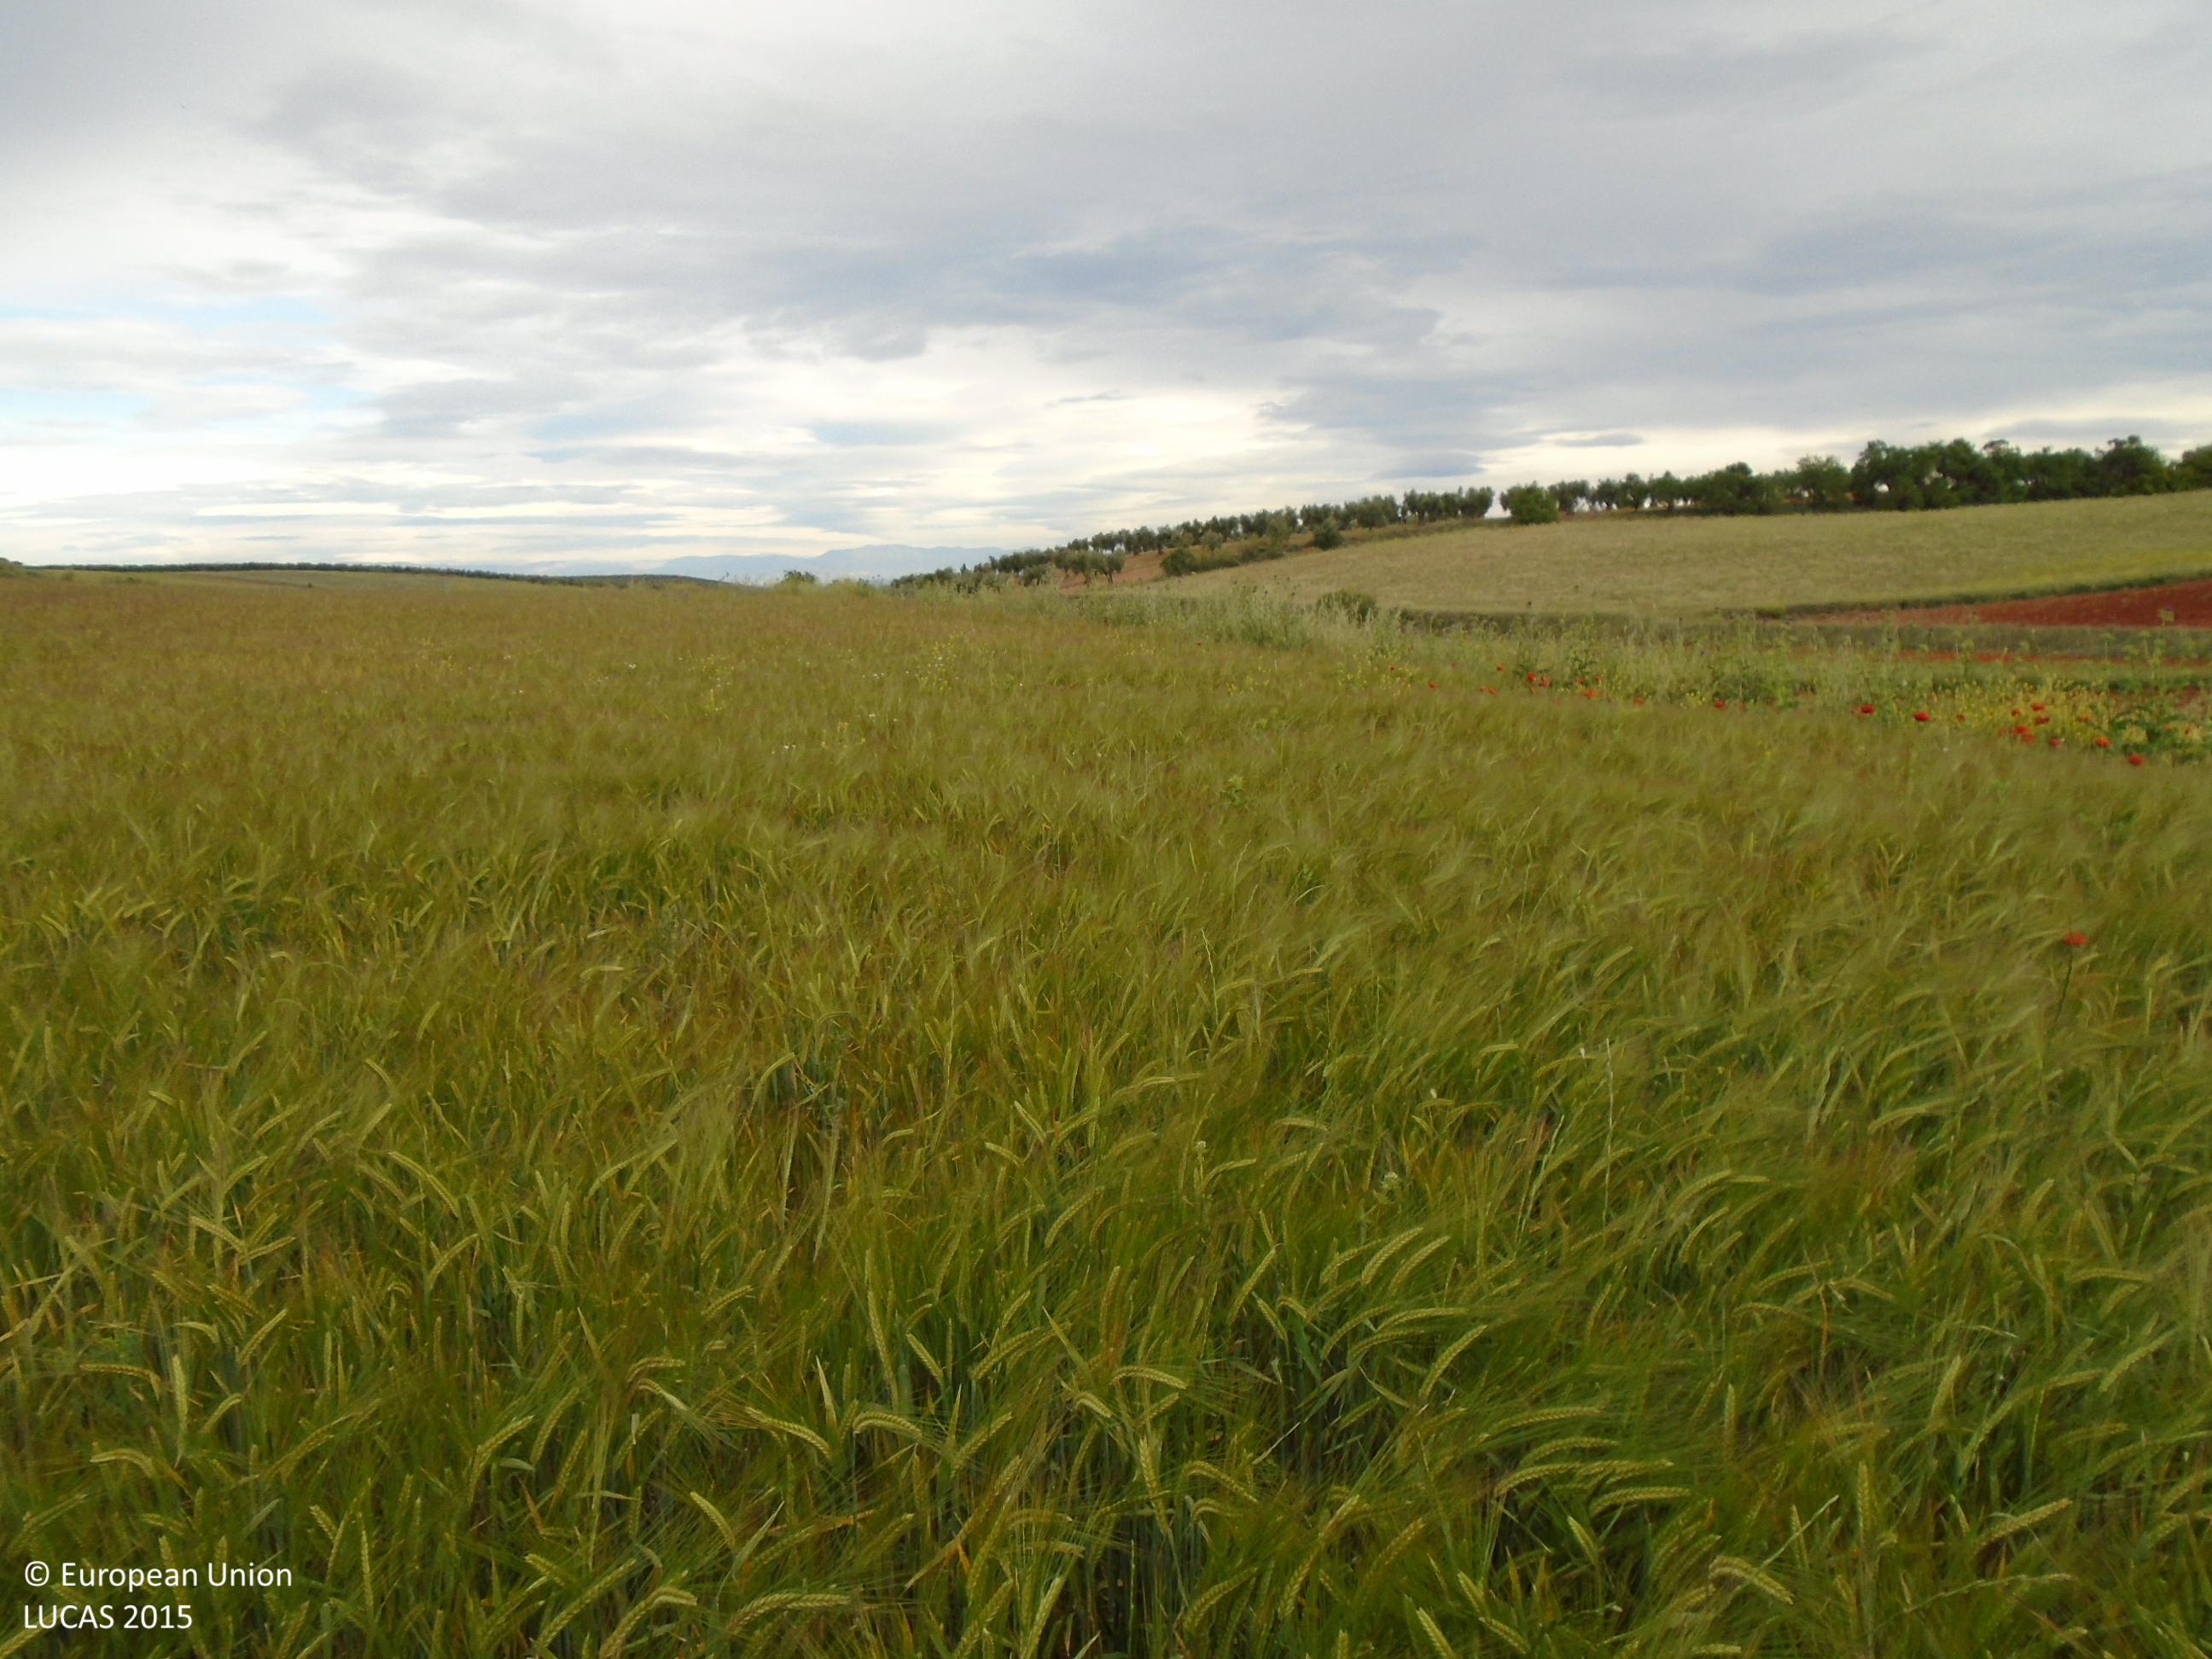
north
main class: Cropland
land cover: Barley
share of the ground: > 75 %
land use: Agriculture (excluding fallow land and kitchen gardens)
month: May
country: ES
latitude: 39.7283
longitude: -4.6607
